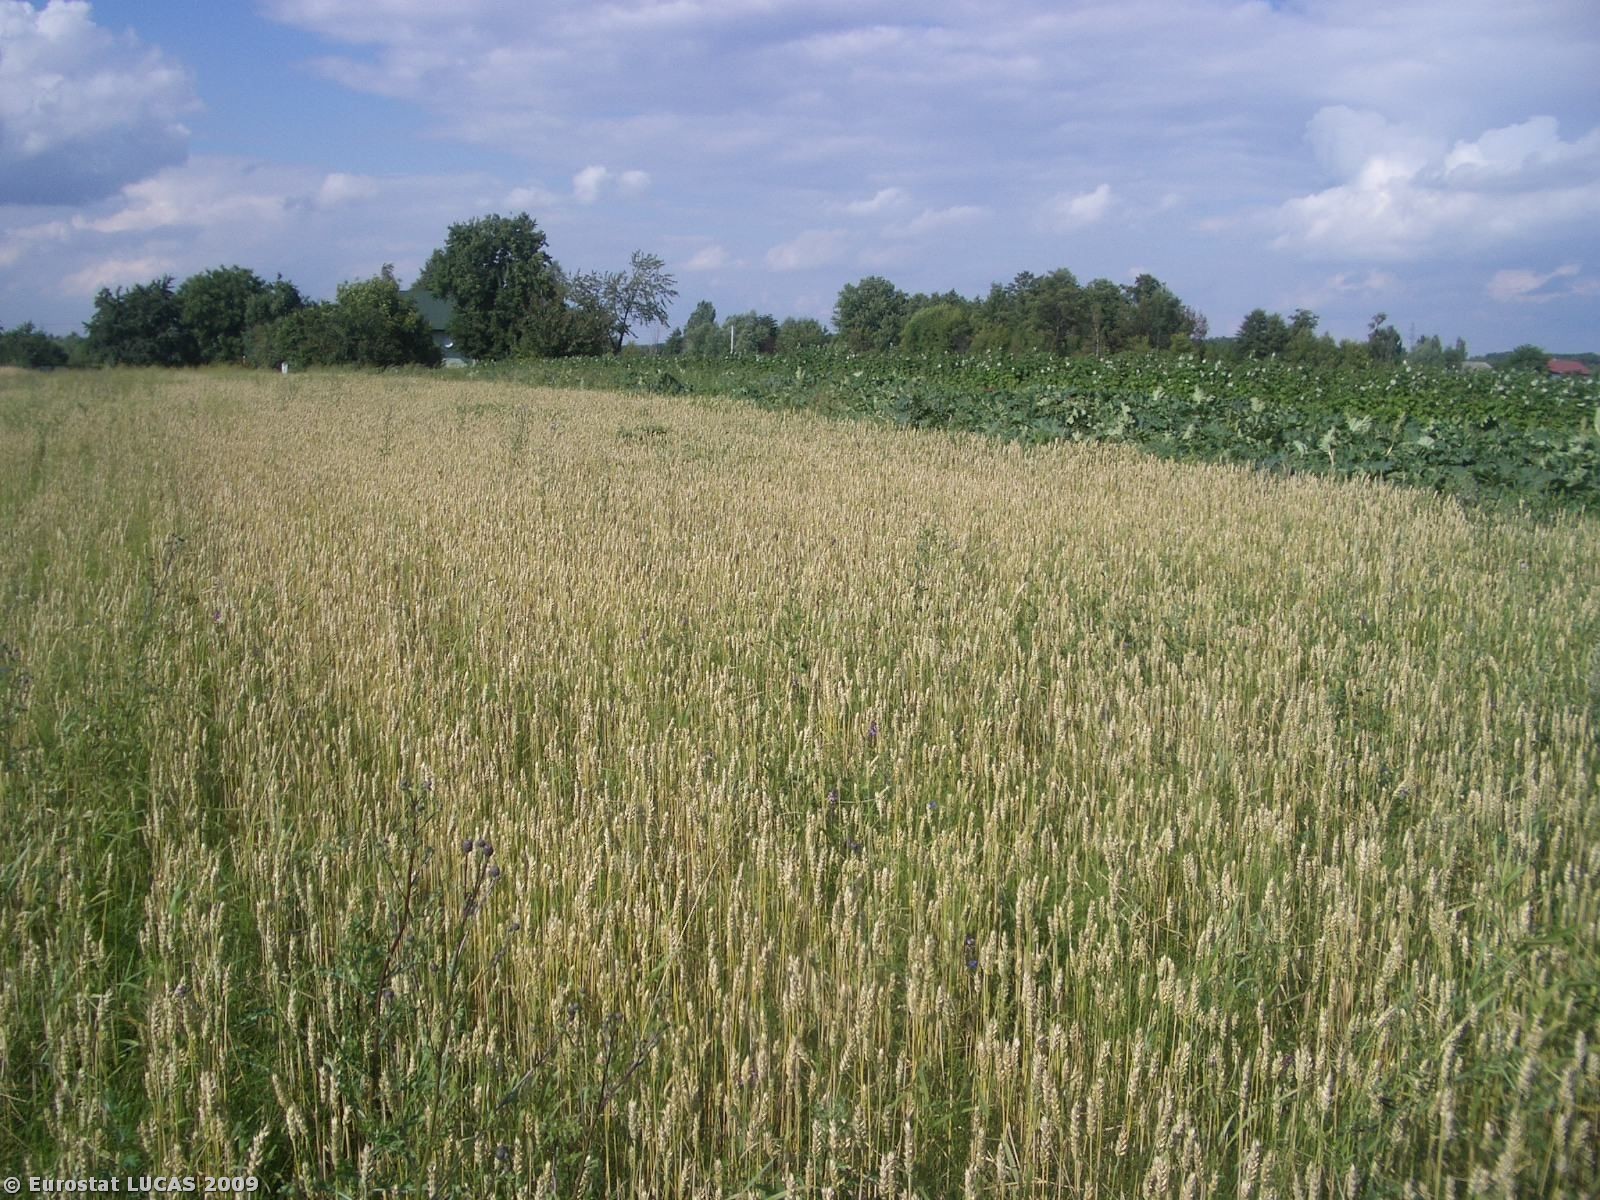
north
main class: Cropland
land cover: Common wheat
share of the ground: 50 - 75 %
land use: Agriculture (excluding fallow land and kitchen gardens)
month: July
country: PL
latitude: 51.6252
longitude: 22.4745
